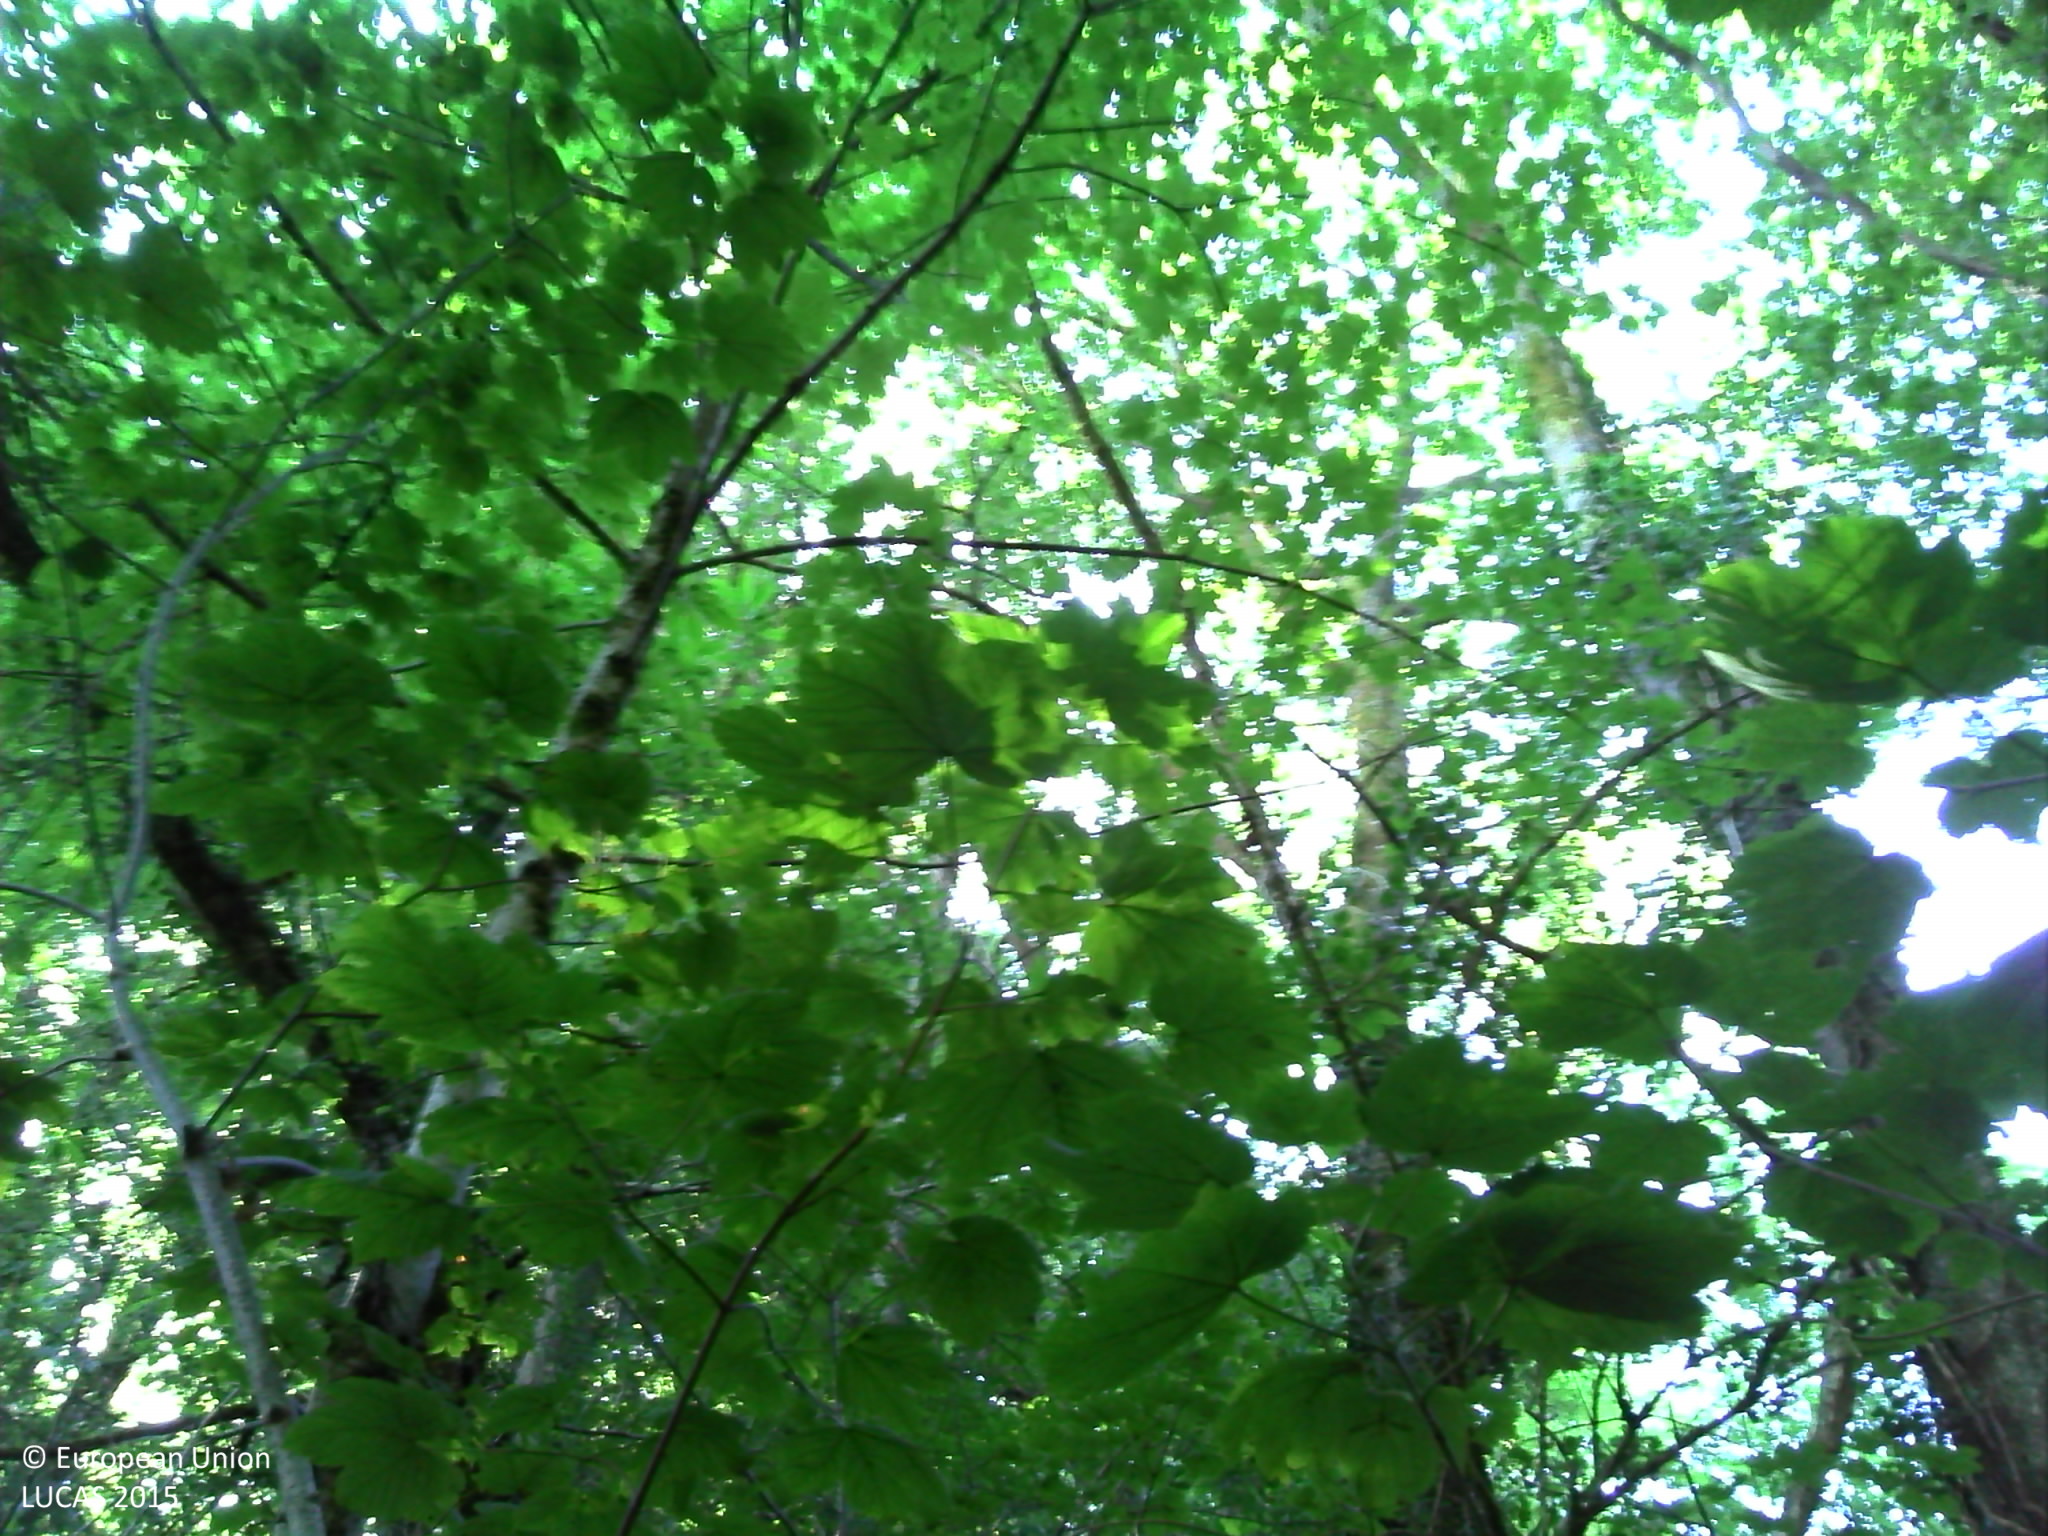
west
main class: Woodland
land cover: Broadleaved woodland
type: acidophilous oak and oak-birch forest
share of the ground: > 75 %
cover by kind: broadleaved forest trees 40 %, herbaceous plants 40 %, lichens and mosses 20 %
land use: Forestry
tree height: > 5 m
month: July
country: FR
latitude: 45.7409
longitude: 1.7297
